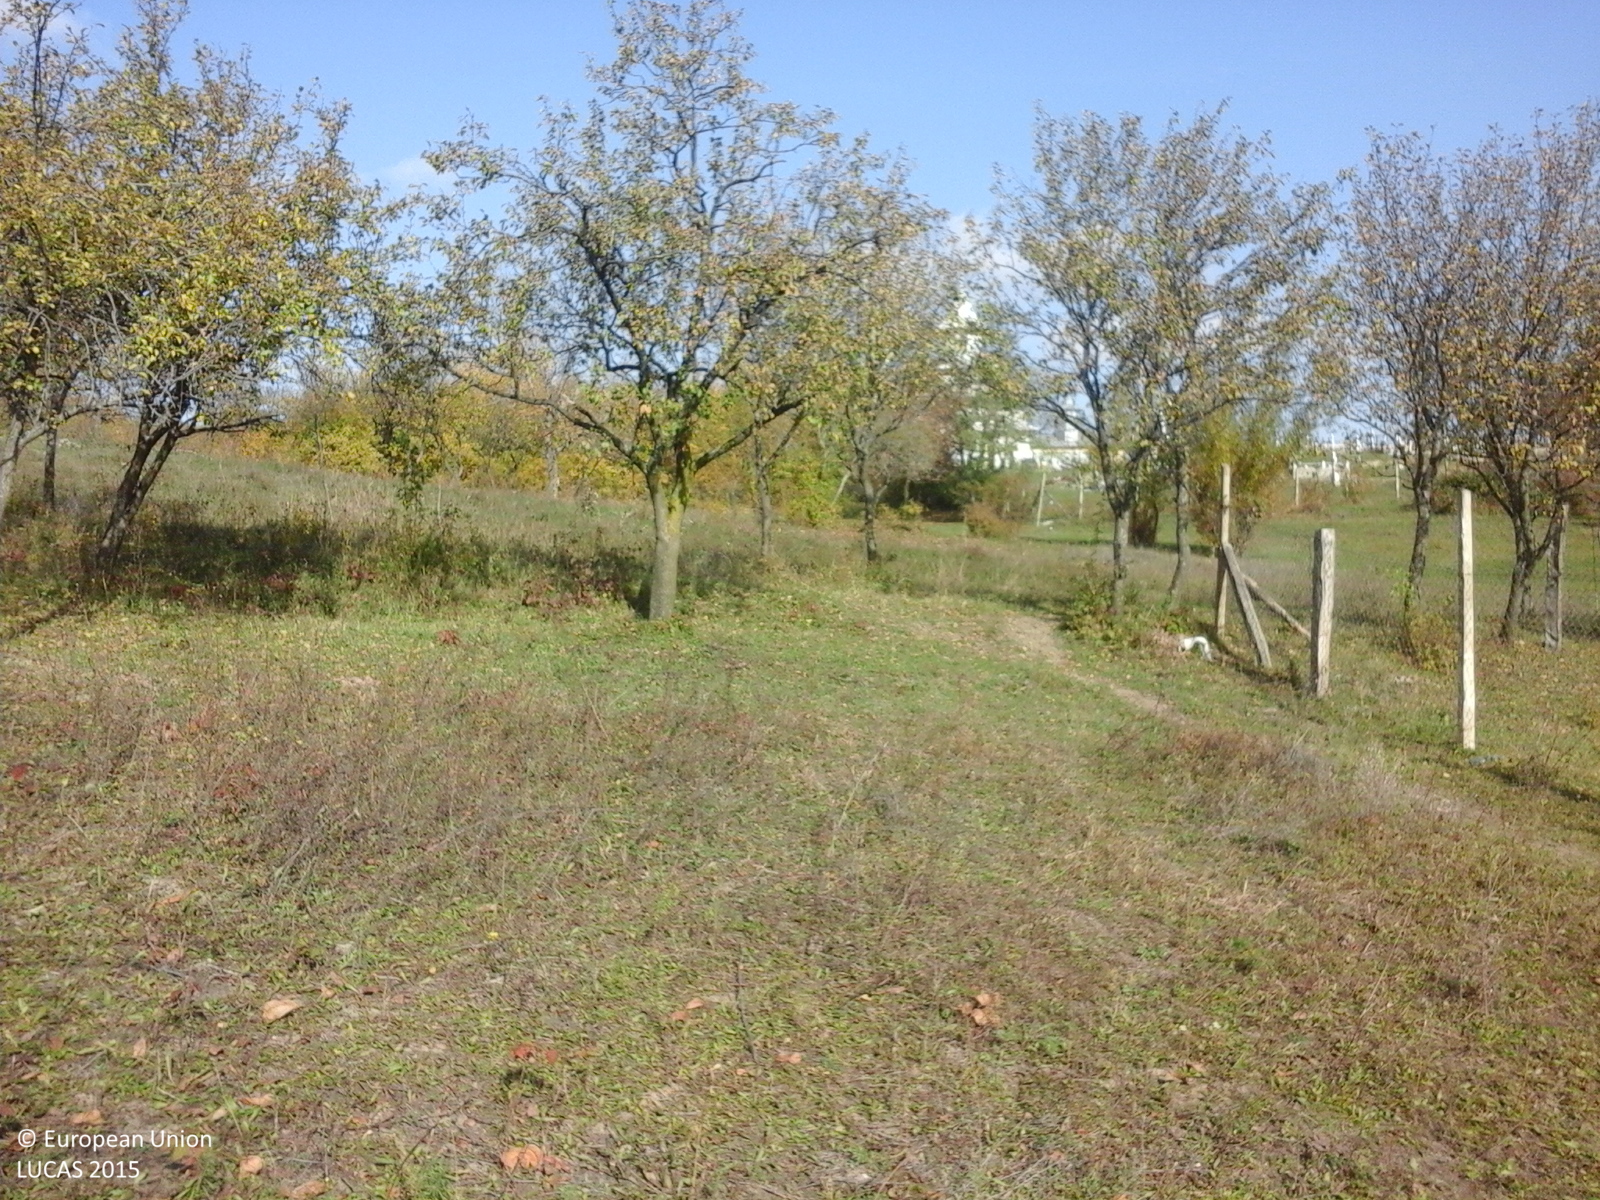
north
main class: Cropland
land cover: Nuts trees
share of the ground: > 75 %
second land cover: Grassland without tree/shrub cover
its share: > 75 %
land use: Agriculture (excluding fallow land and kitchen gardens)
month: October
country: RO
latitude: 45.6594
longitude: 26.9913
